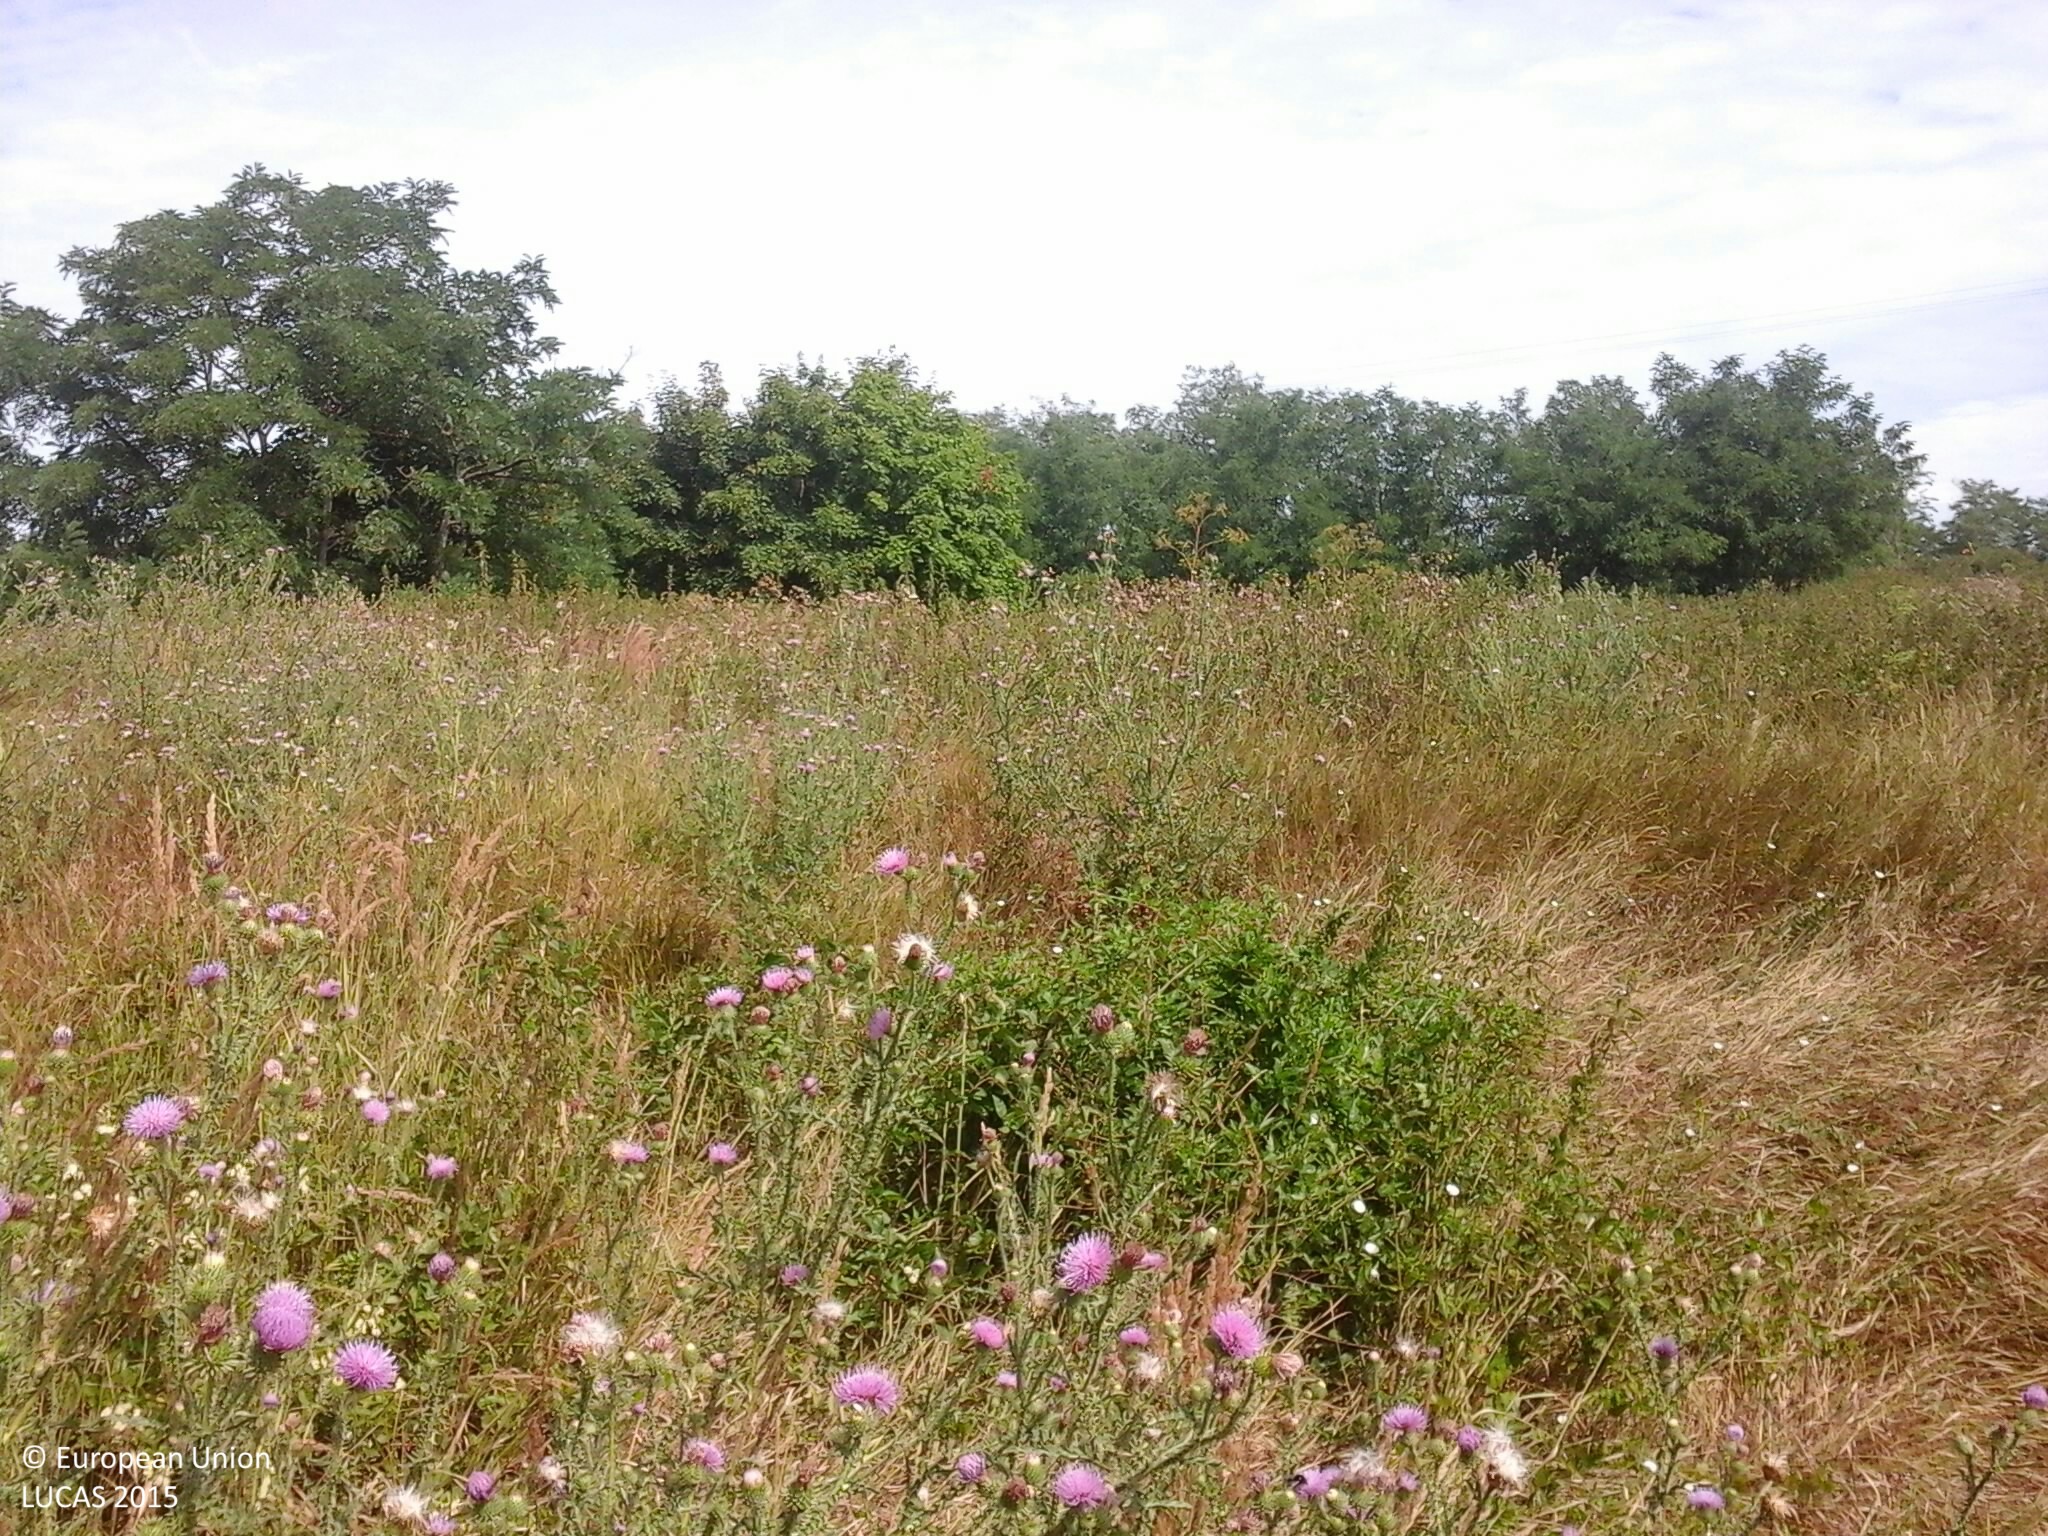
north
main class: Grassland
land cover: Spontaneously vegetated surfaces
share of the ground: > 75 %
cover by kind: herbaceous plants 100 %
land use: Abandoned areas
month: July
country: HU
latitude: 47.9162
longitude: 19.1324
